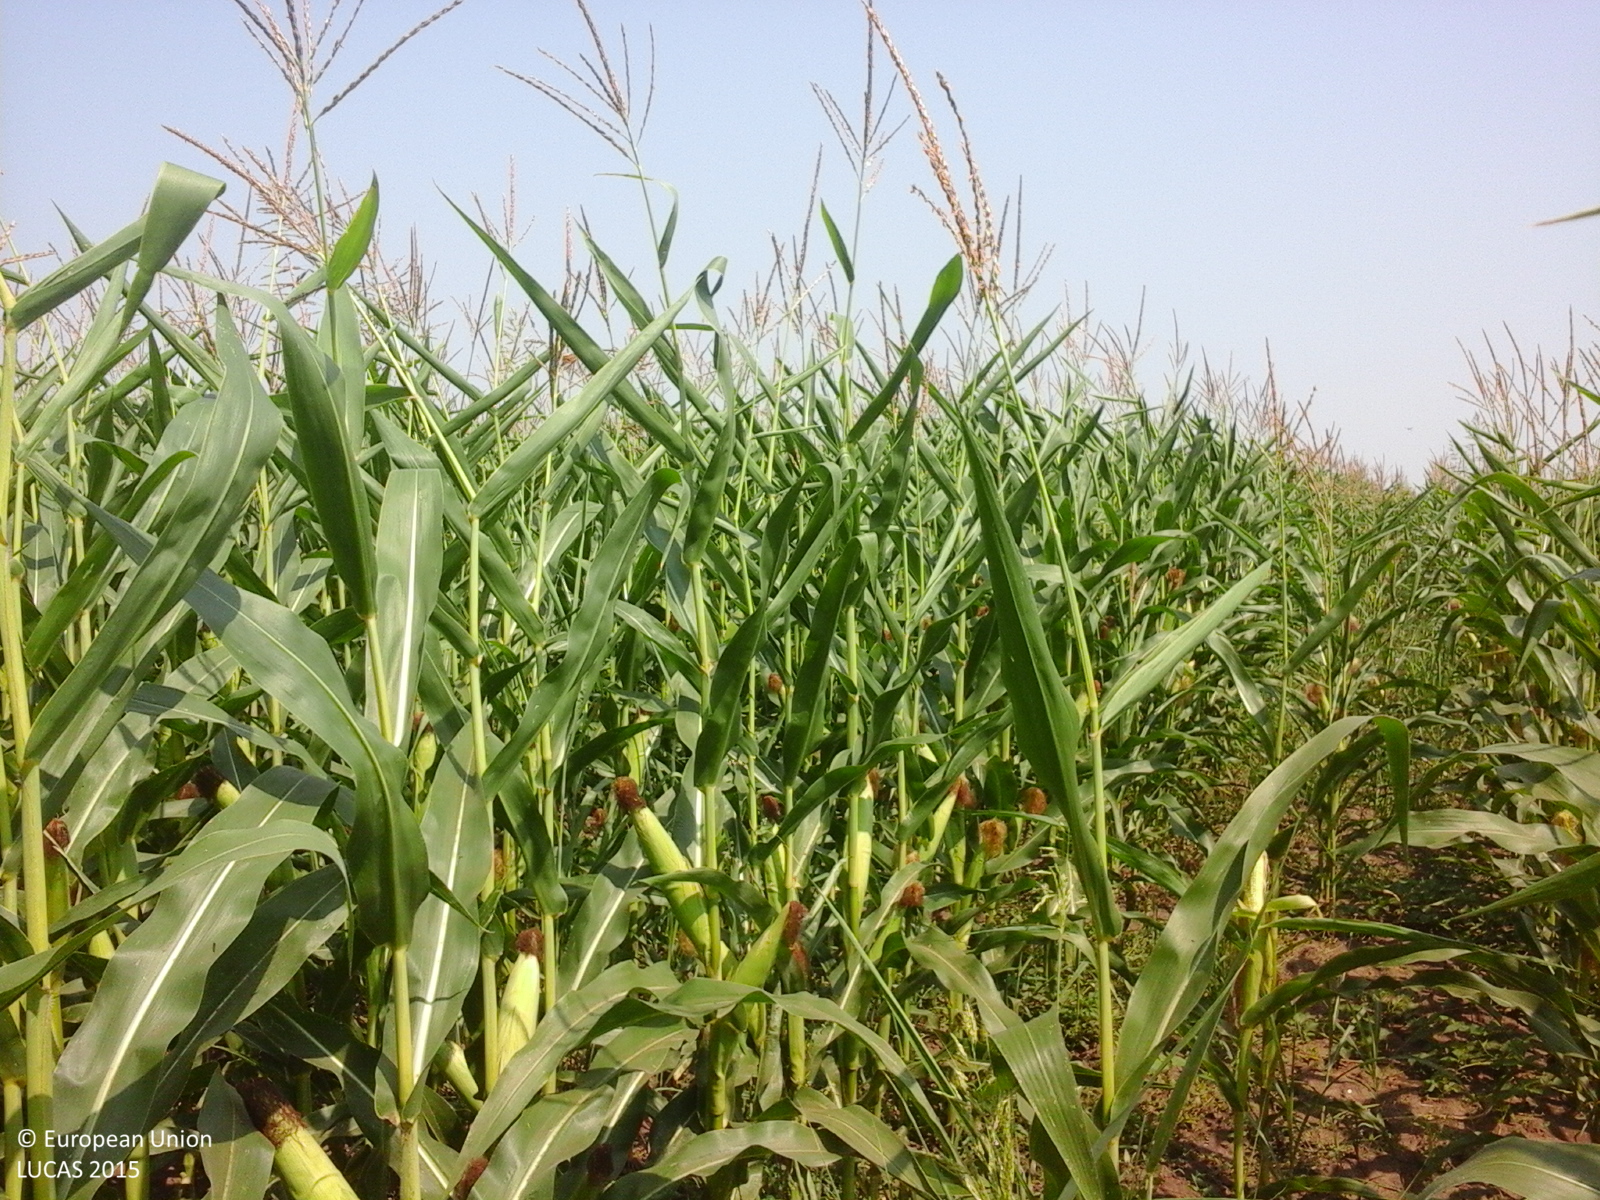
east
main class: Cropland
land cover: Maize
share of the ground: > 75 %
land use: Agriculture (excluding fallow land and kitchen gardens)
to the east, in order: Maize
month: July
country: RO
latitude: 44.6059
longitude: 26.4576
